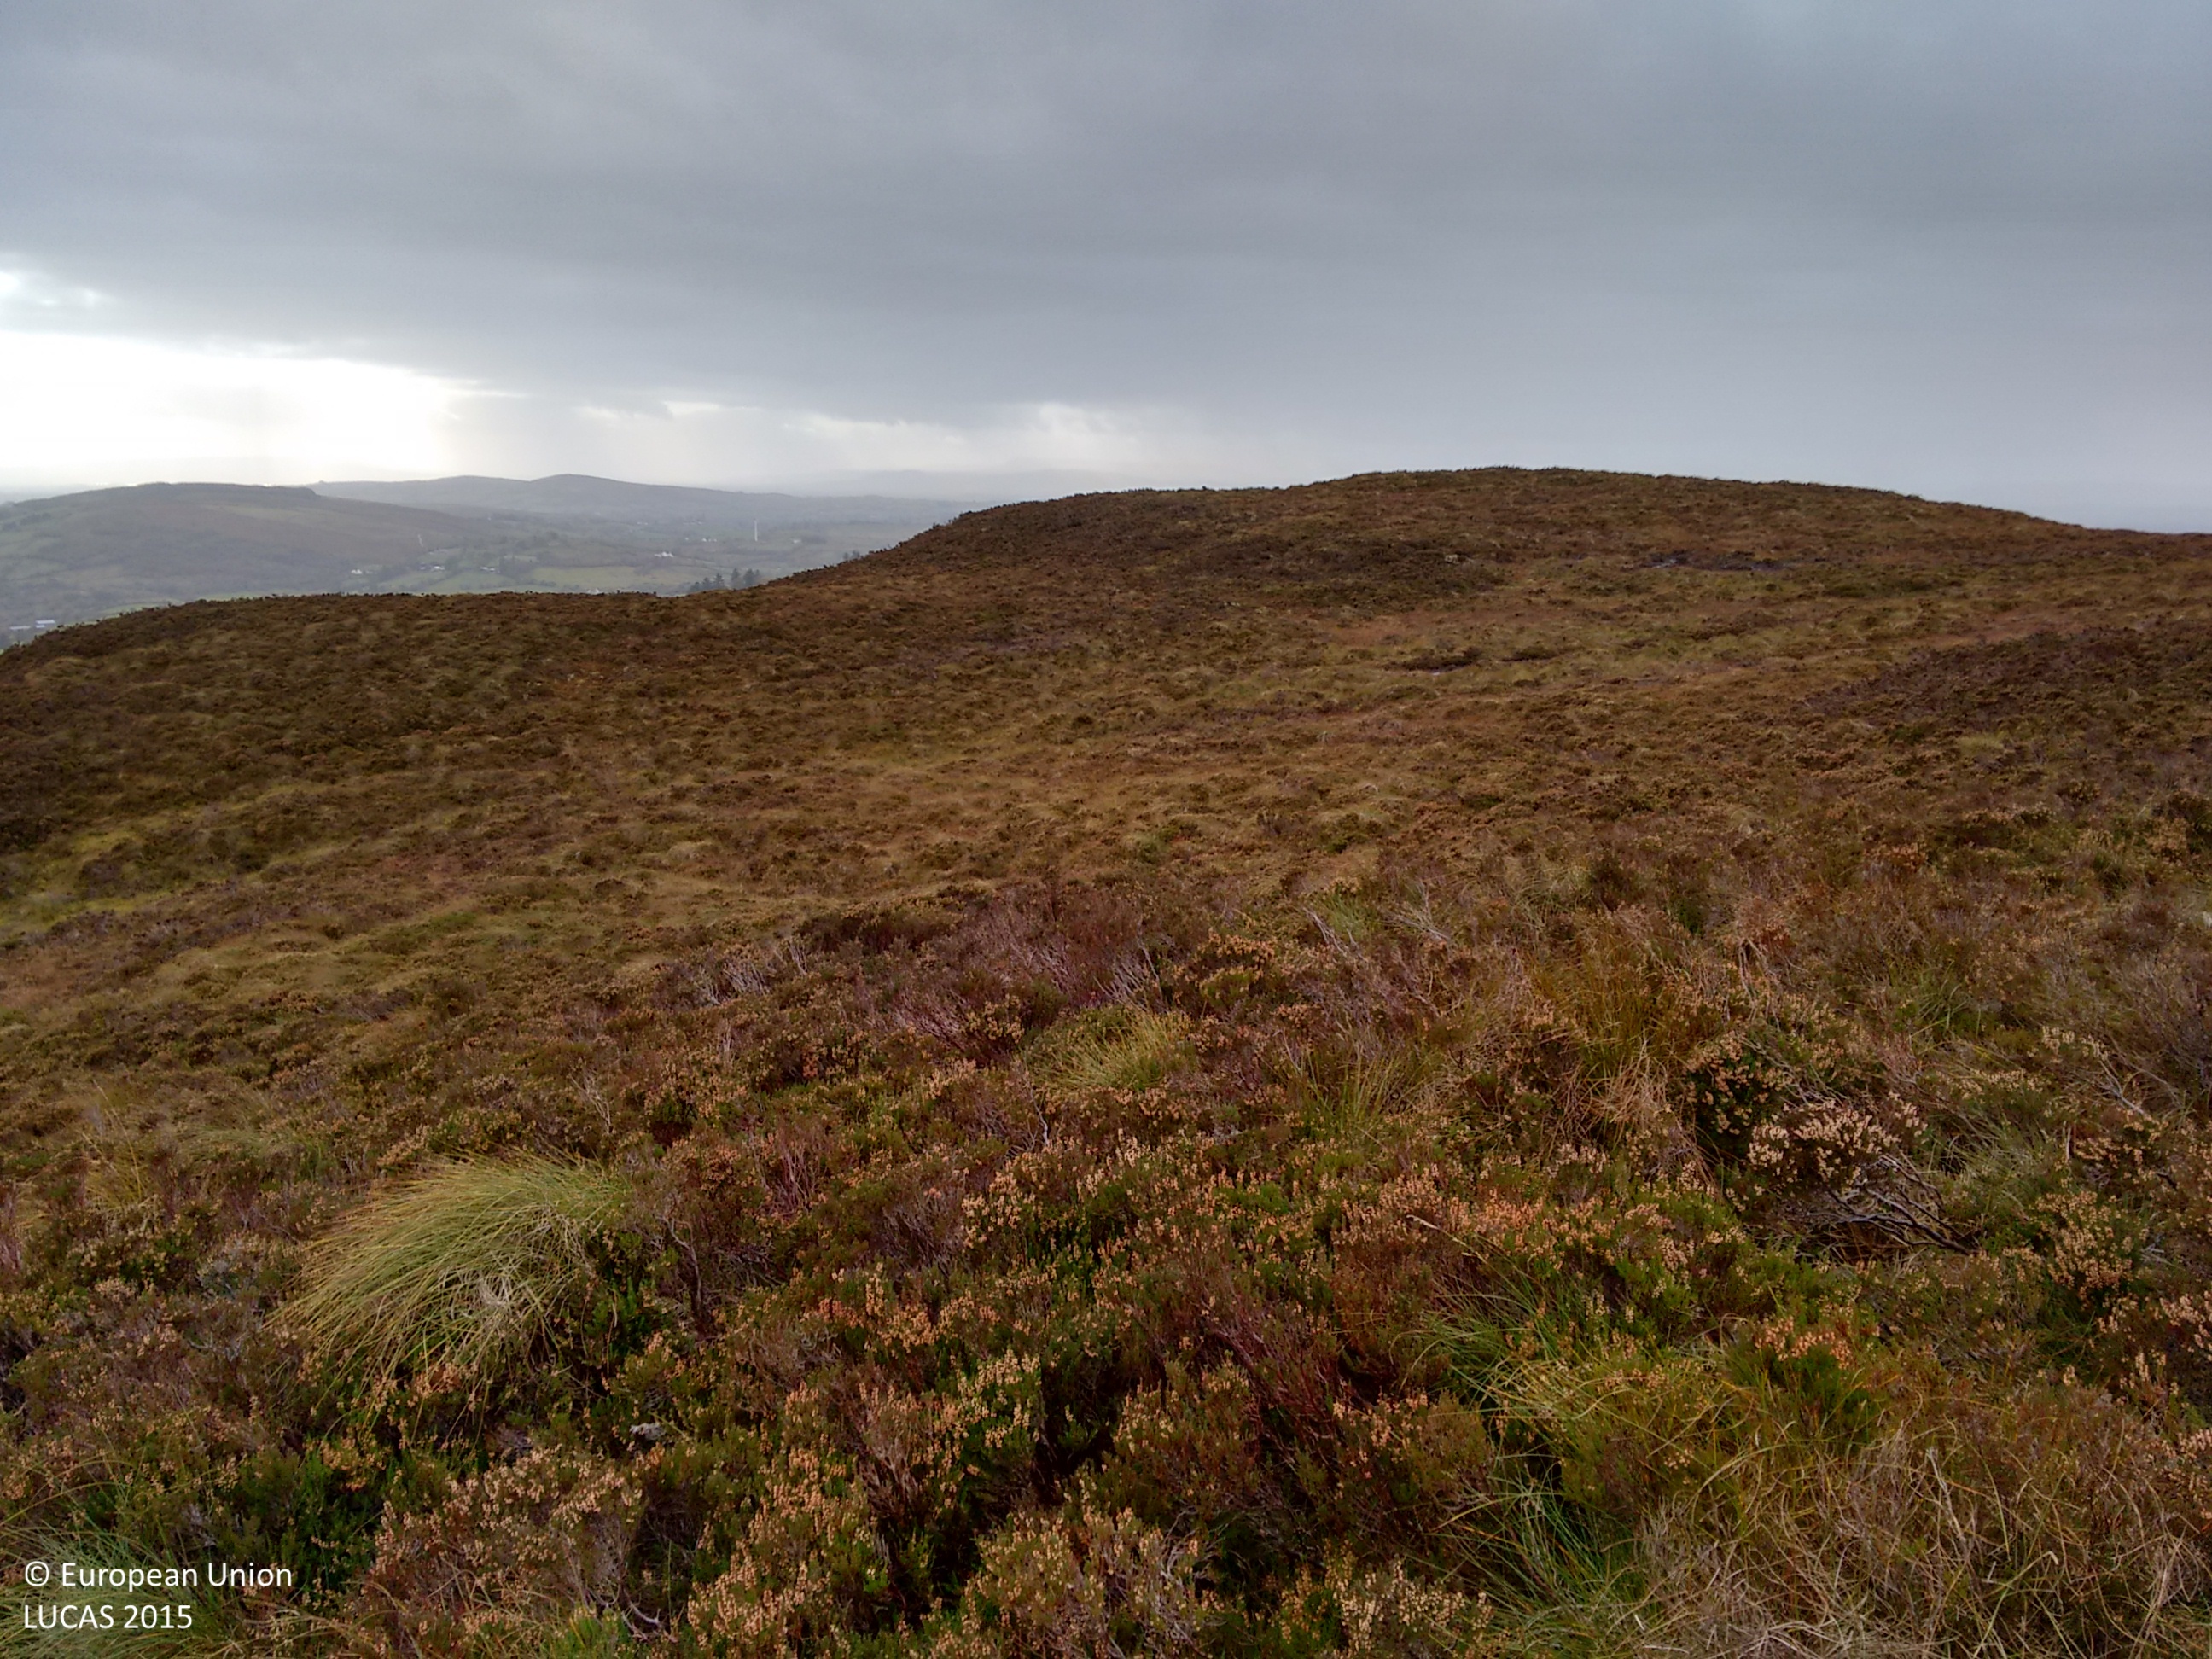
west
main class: Shrubland
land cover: Shrubland without tree cover
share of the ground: > 75 %
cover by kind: shrubs 80 %, lichens and mosses 20 %
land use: Agriculture (excluding fallow land and kitchen gardens)
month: October
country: GB
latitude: 54.4223
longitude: -7.4626
